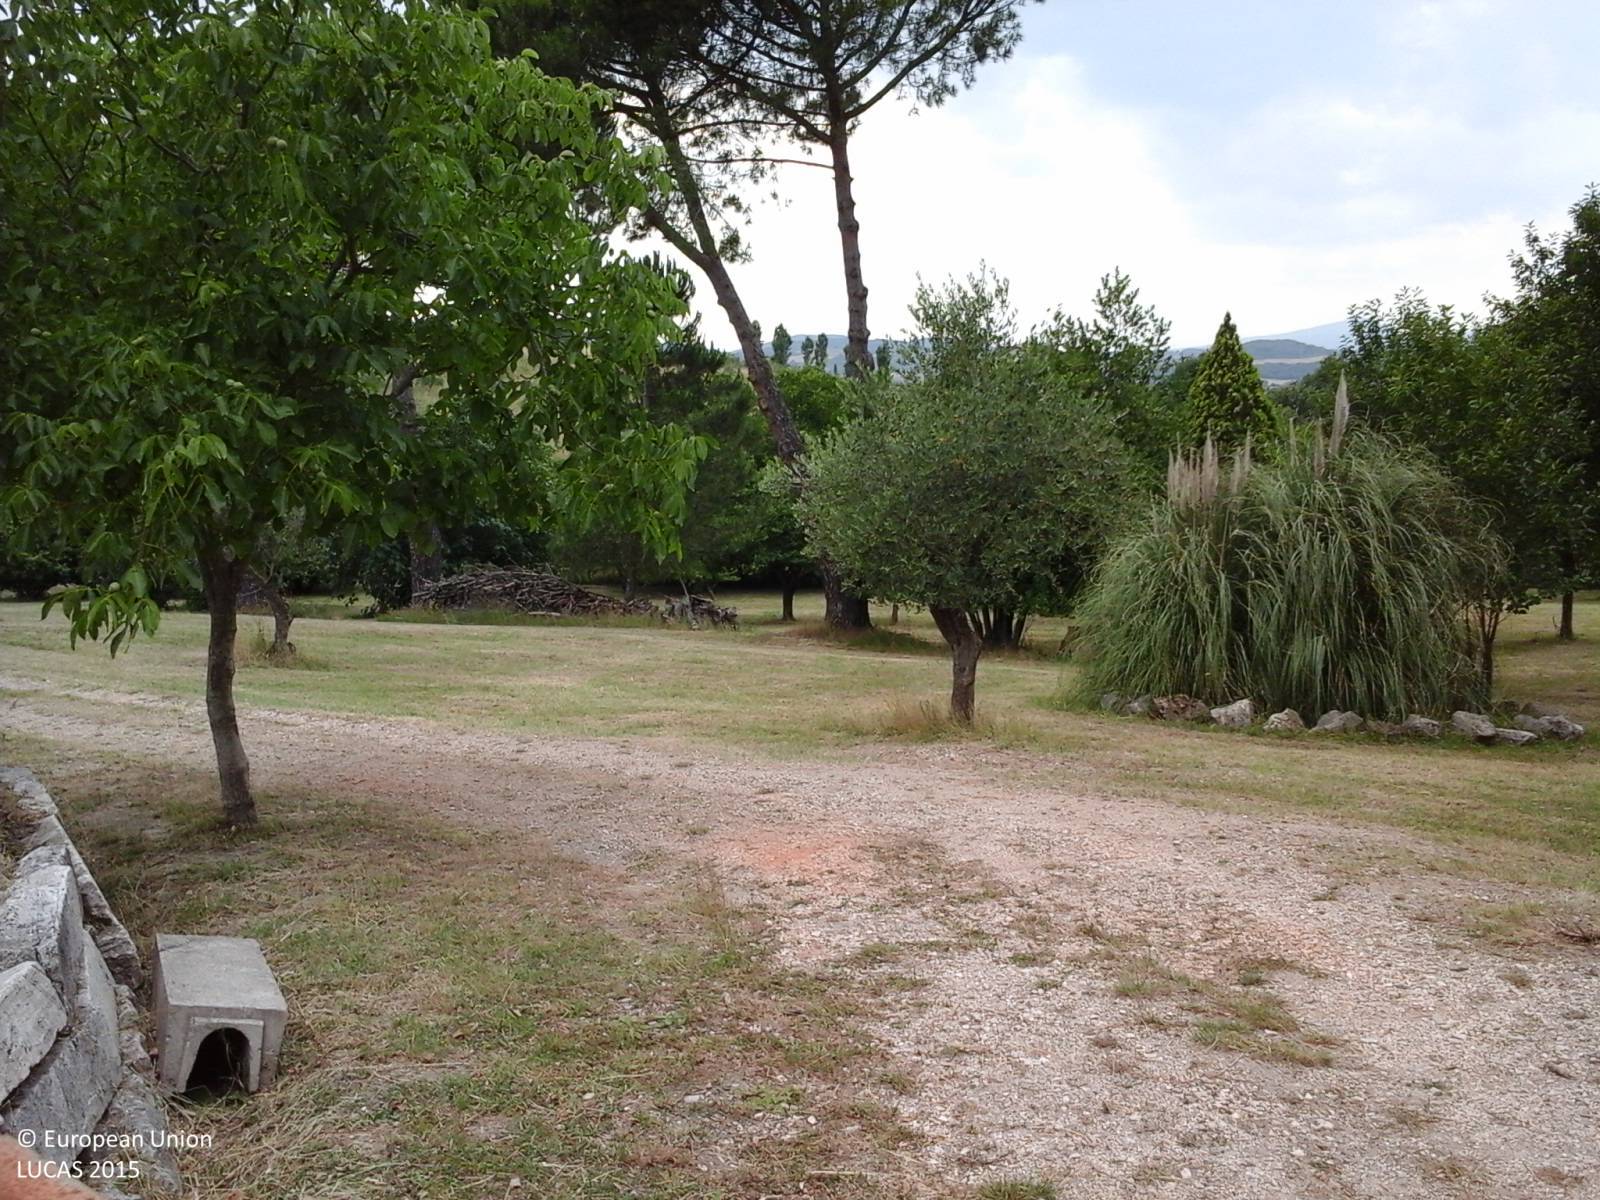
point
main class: Woodland
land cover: Broadleaved woodland
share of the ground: 50 - 75 %
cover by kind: herbaceous plants 60 %, broadleaved forest trees 15 %, unconsolidated bare surface 15 %, coniferous forest trees 5 %, shrubs 5 %
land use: Residential
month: June
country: IT
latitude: 42.1388
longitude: 12.3509
